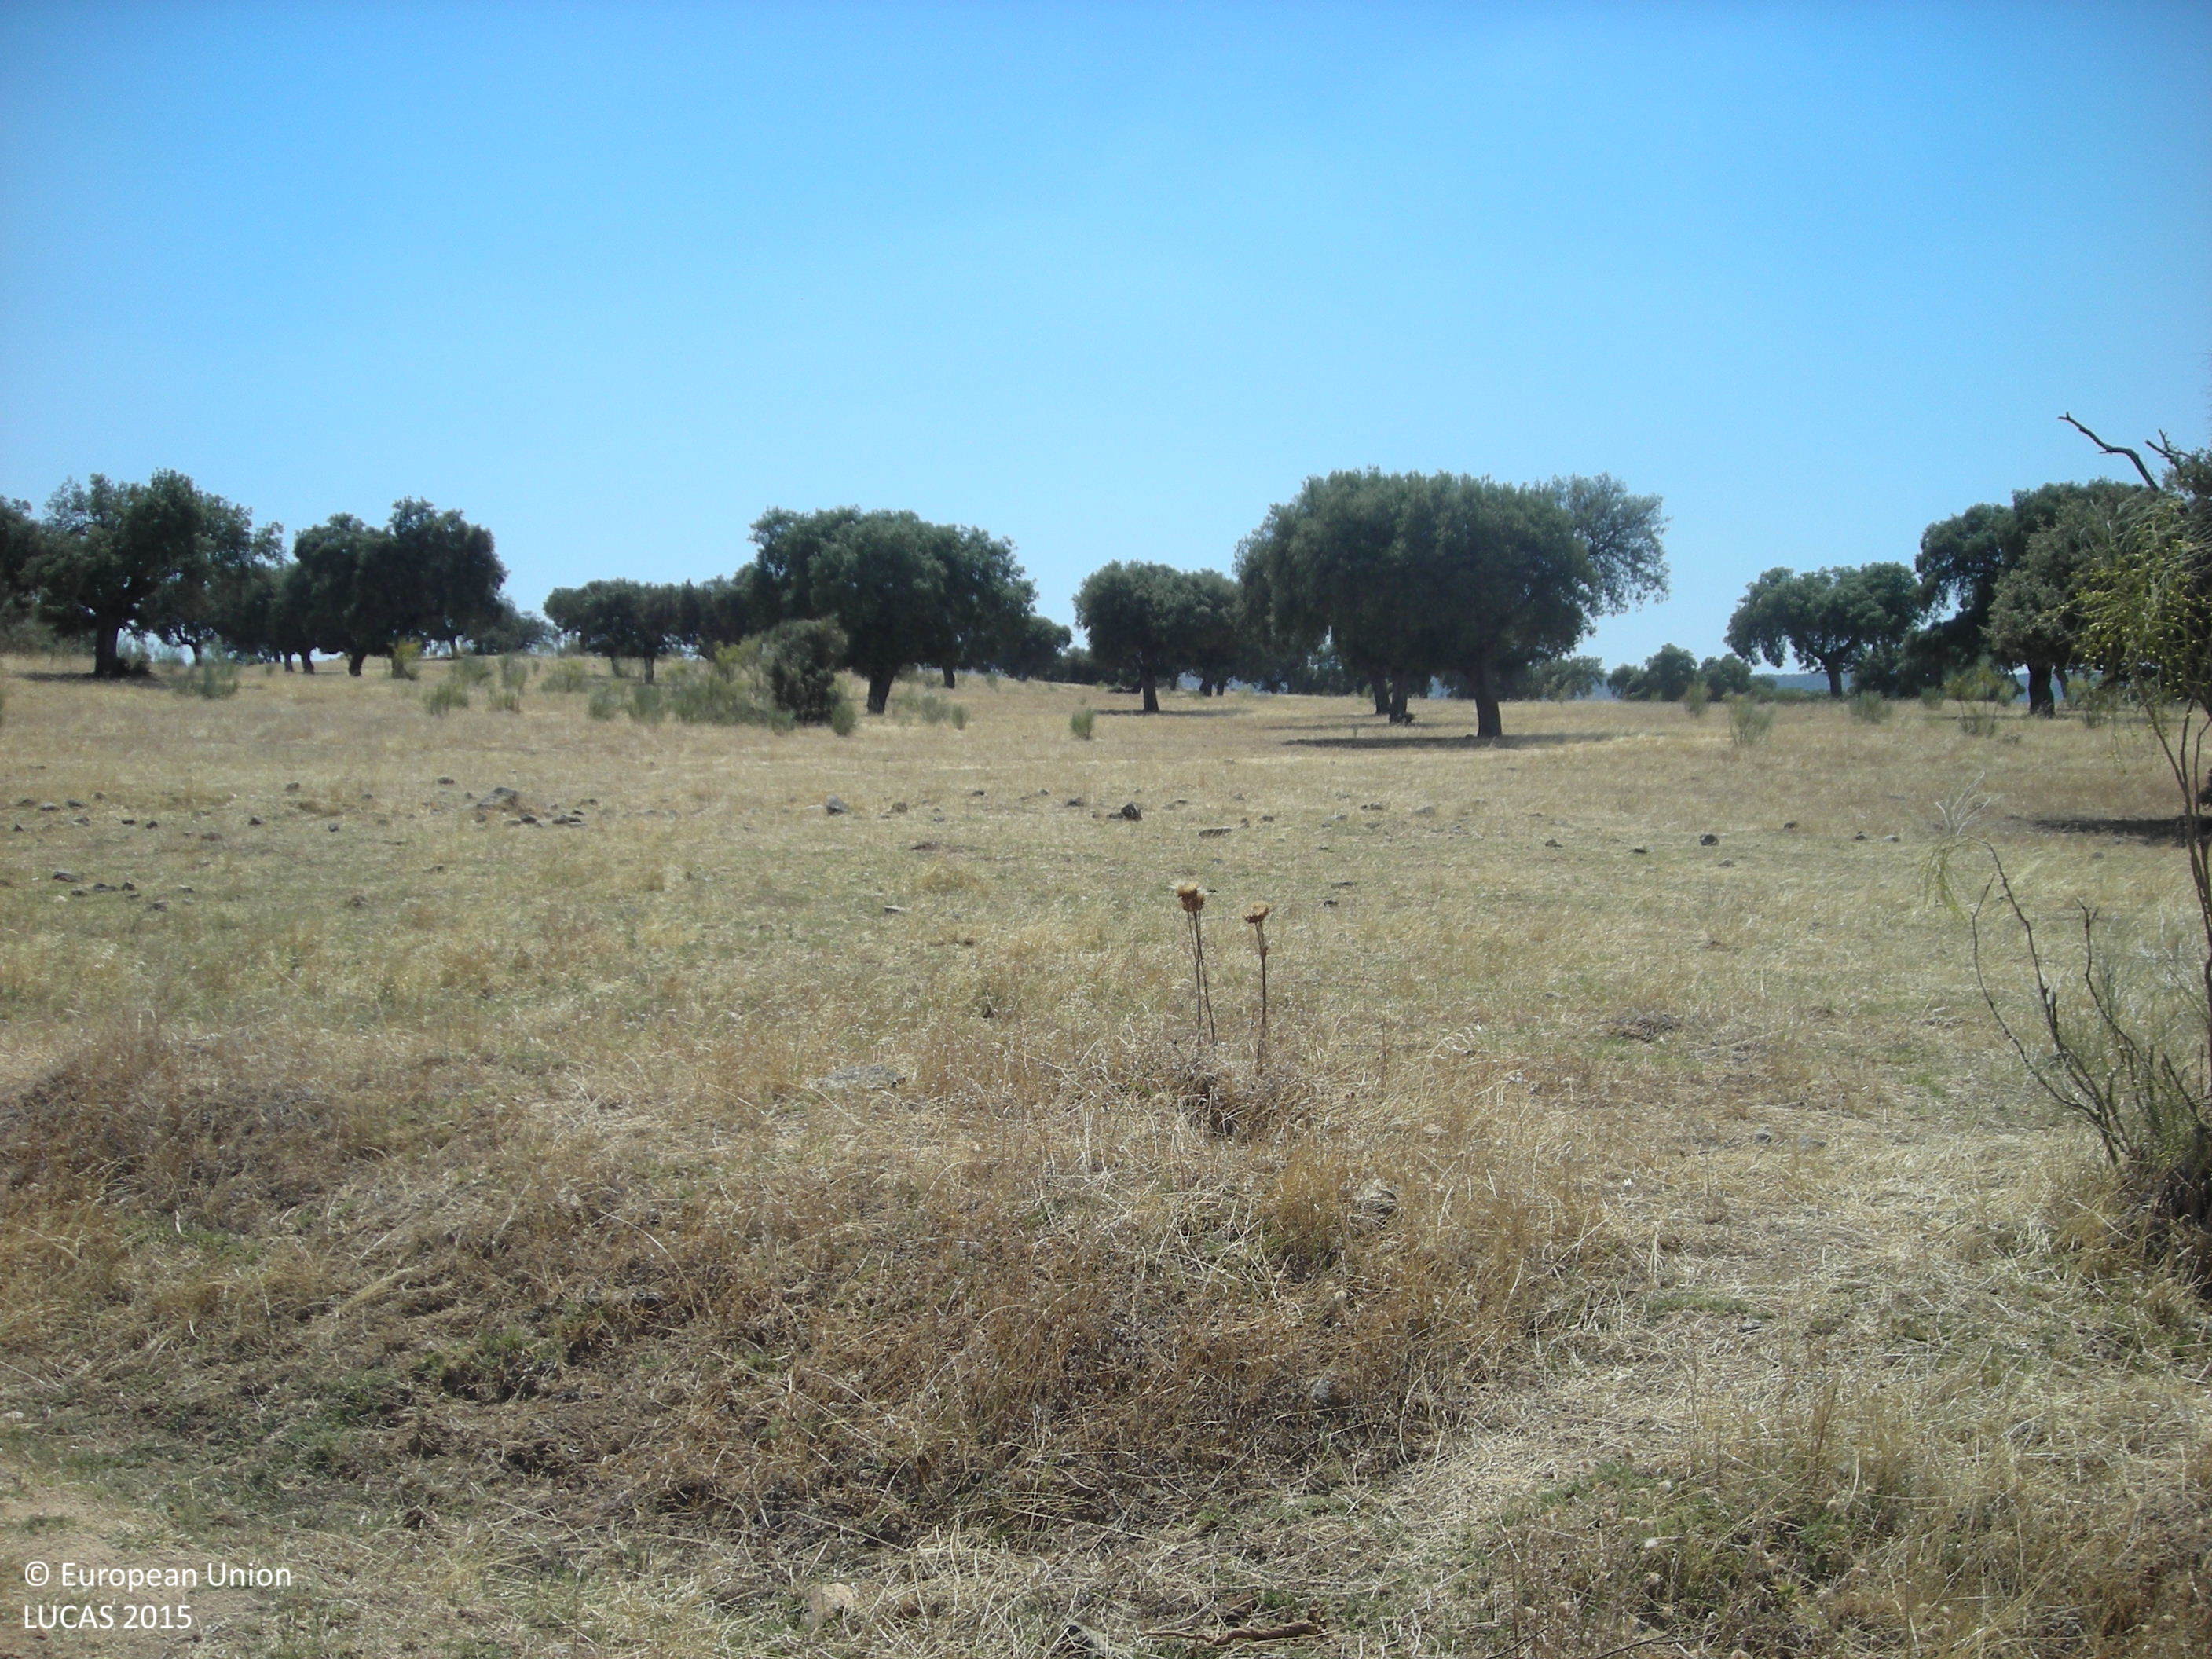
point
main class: Woodland
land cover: Broadleaved woodland
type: broadleaved evergreen forest
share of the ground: 10 - 25 %
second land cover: Grassland without tree/shrub cover
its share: 50 - 75 %
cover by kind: herbaceous plants 60 %, broadleaved forest trees 40 %
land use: Forestry
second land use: Agriculture (excluding fallow land and kitchen gardens)
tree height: > 5 m
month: June
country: ES
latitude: 38.6651
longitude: -5.7998
